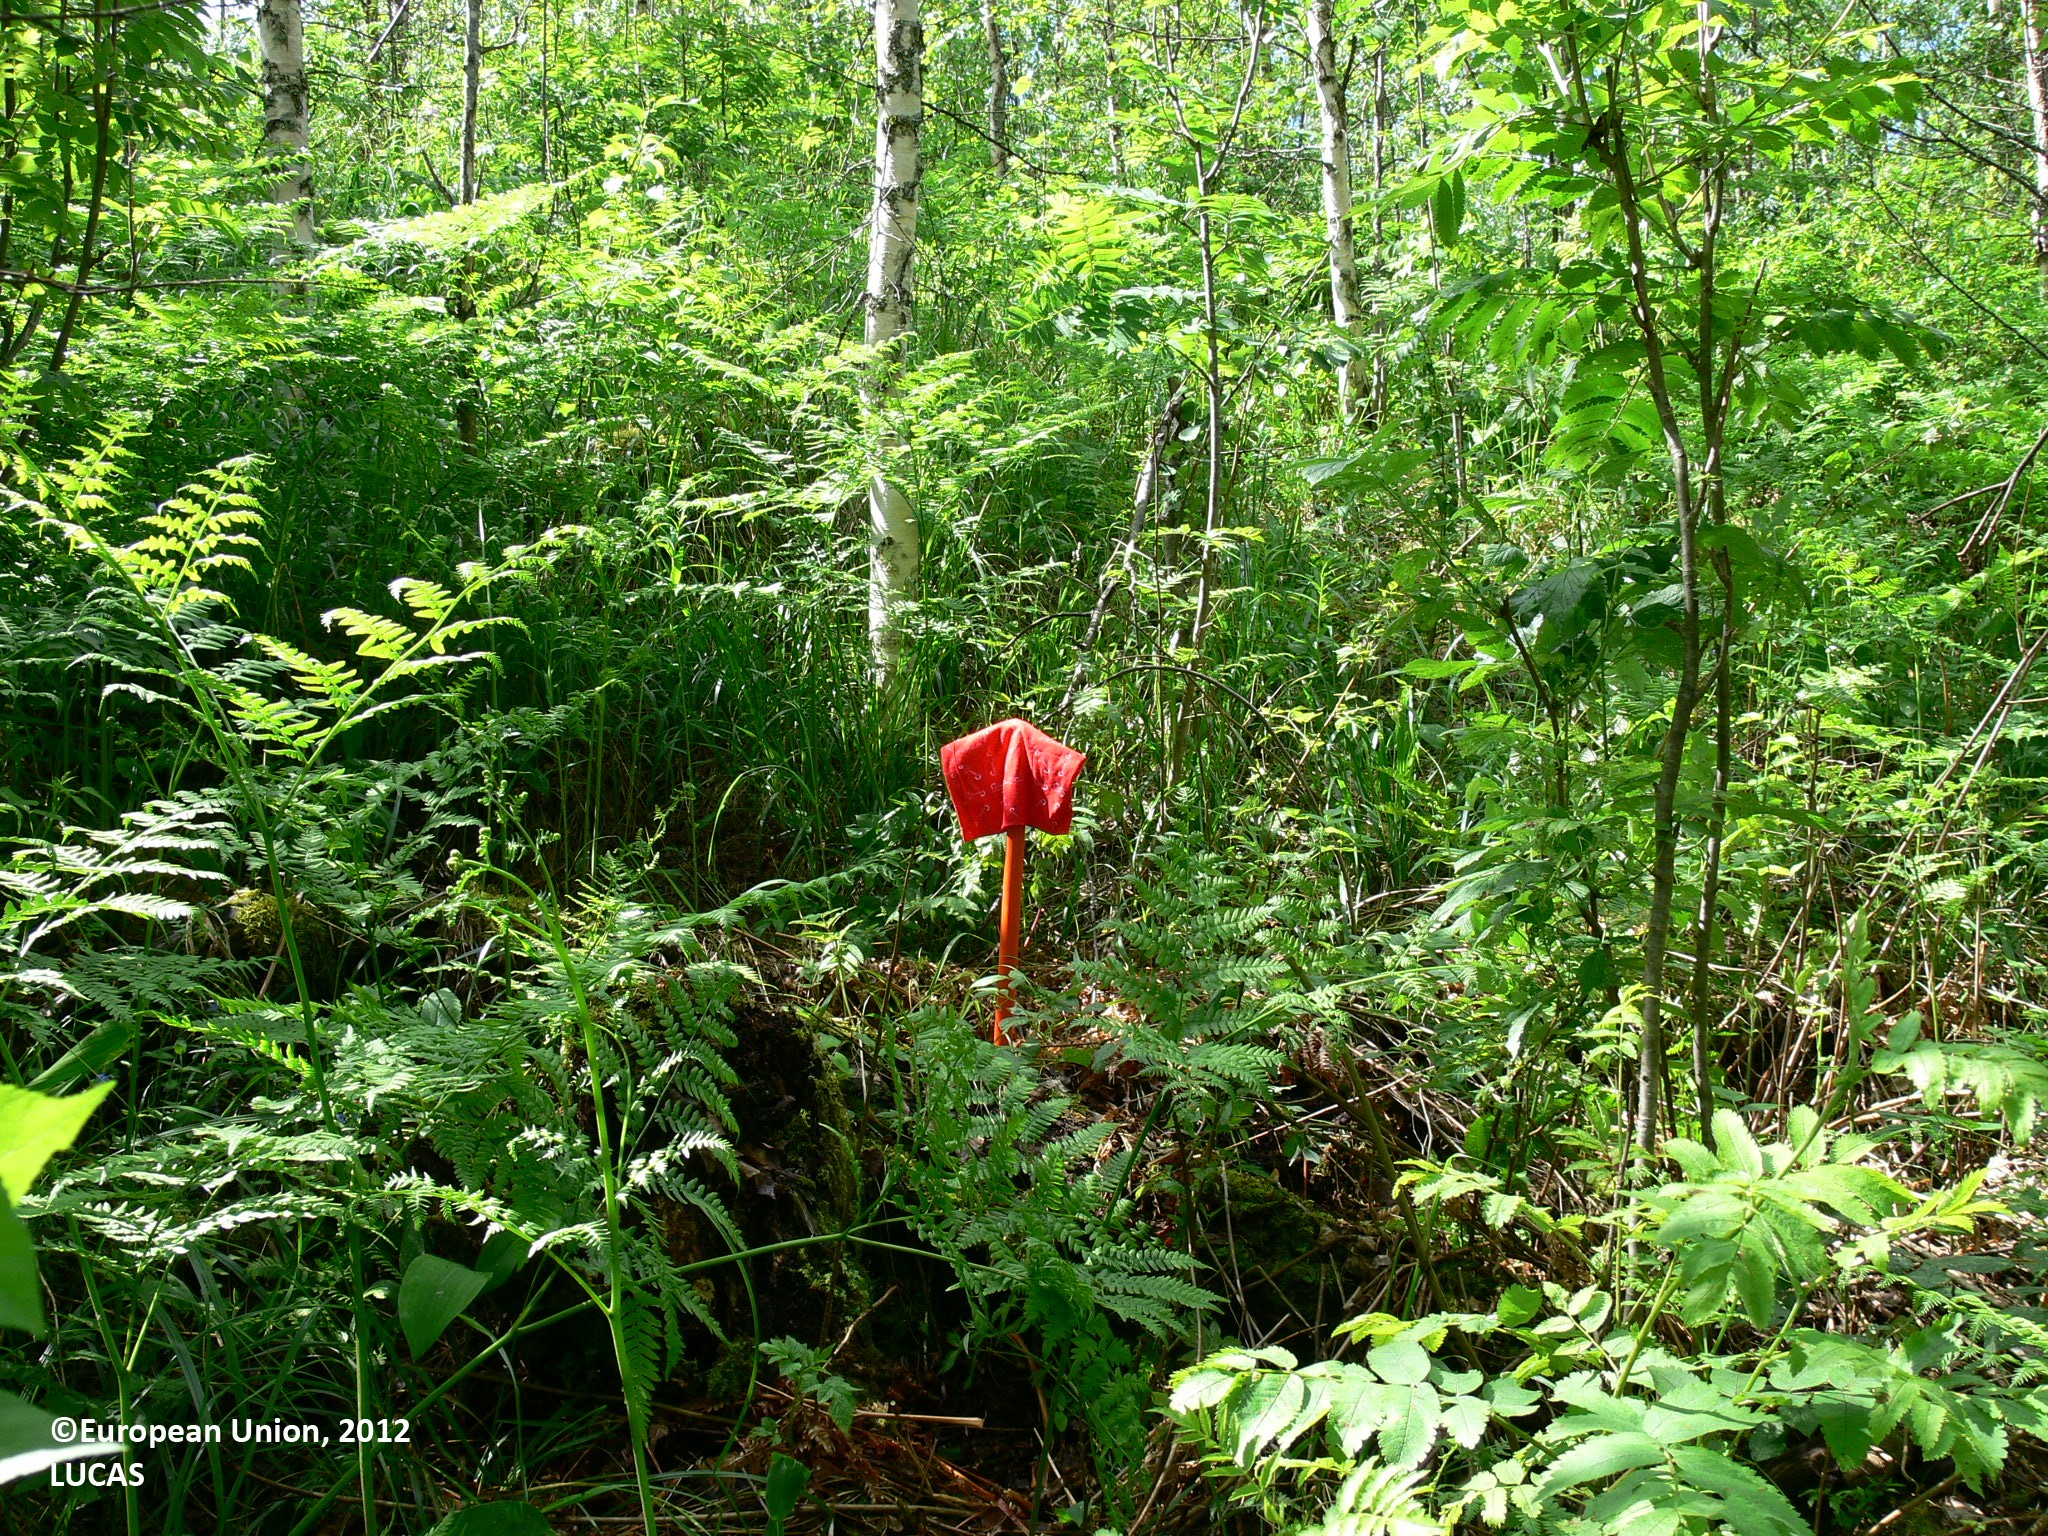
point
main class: Woodland
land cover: Broadleaved woodland
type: boreal forest
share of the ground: 50 - 75 %
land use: Forestry
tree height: > 5 m
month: June
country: FI
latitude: 62.3329
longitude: 30.1327
